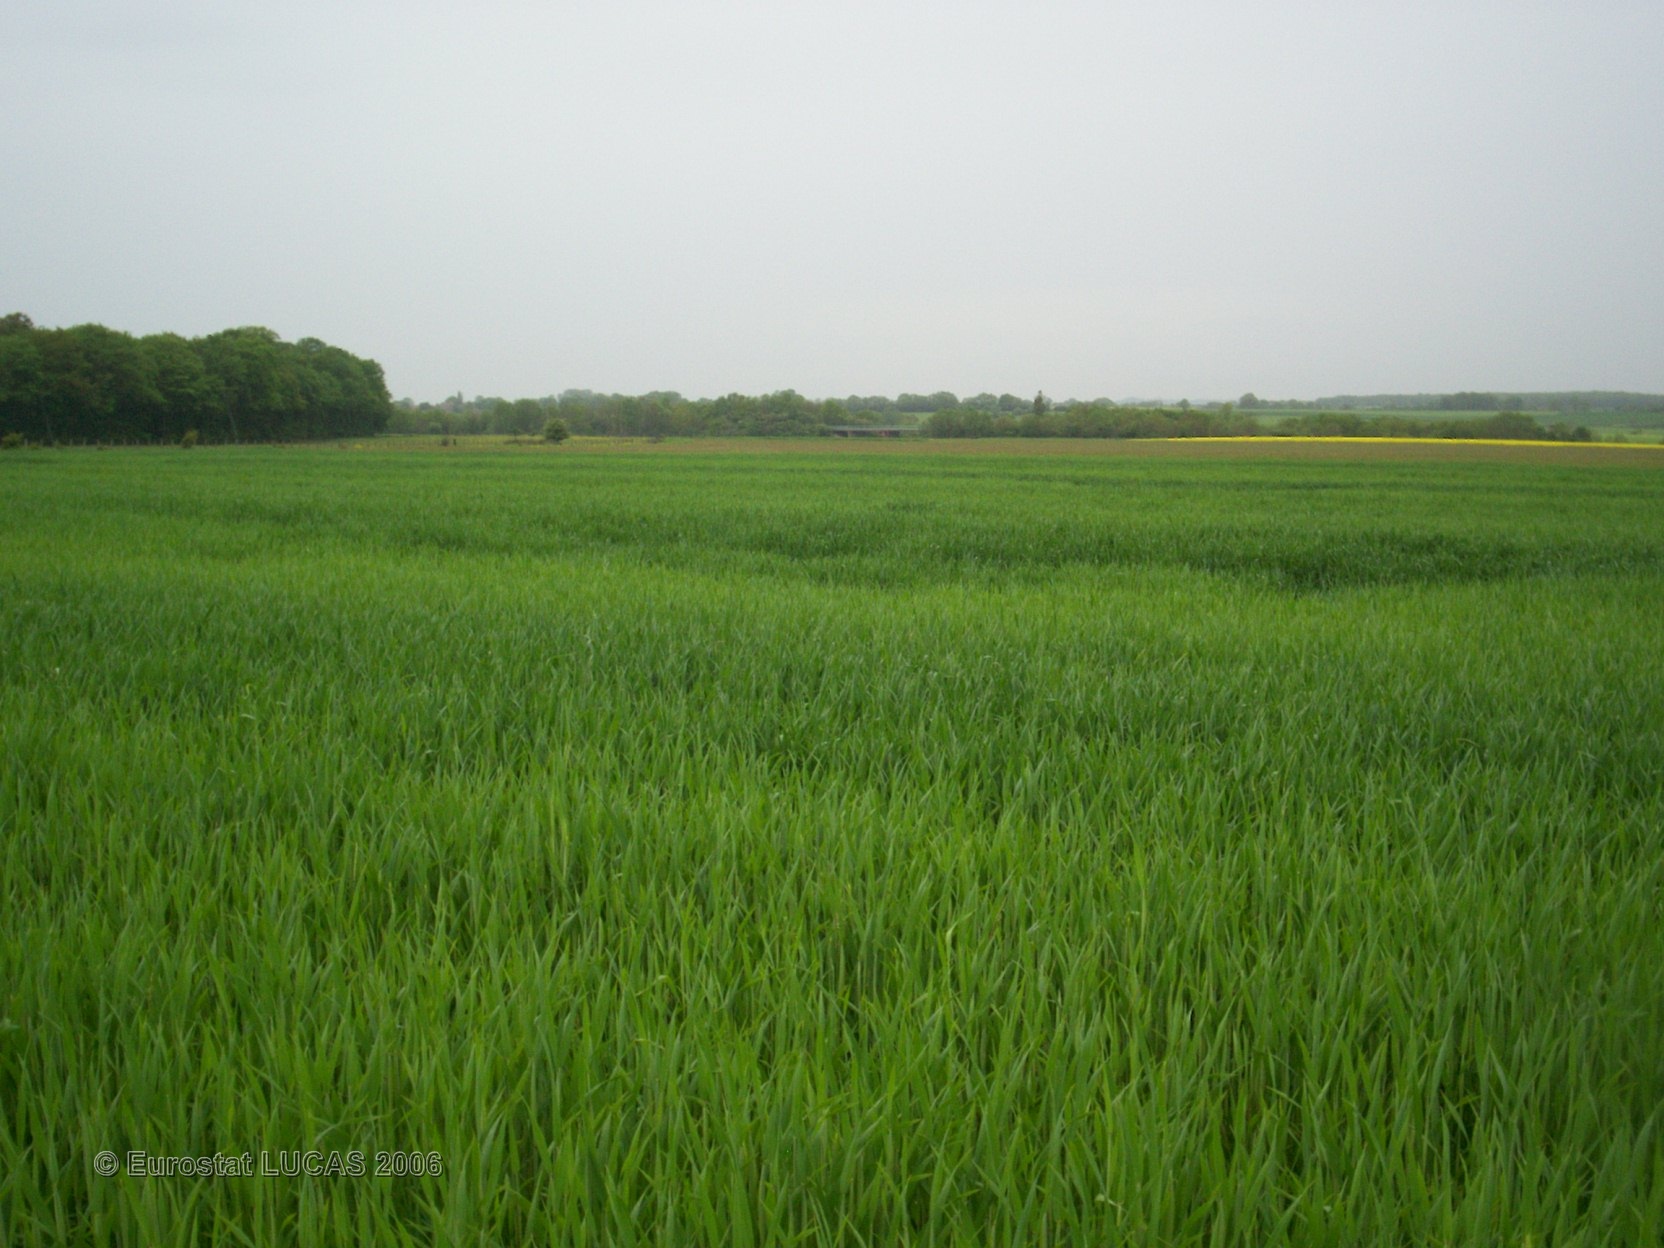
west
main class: Cropland
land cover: Barley
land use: Agriculture (excluding fallow land and kitchen gardens)
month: May
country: FR
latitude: 47.2253
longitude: 4.5984
